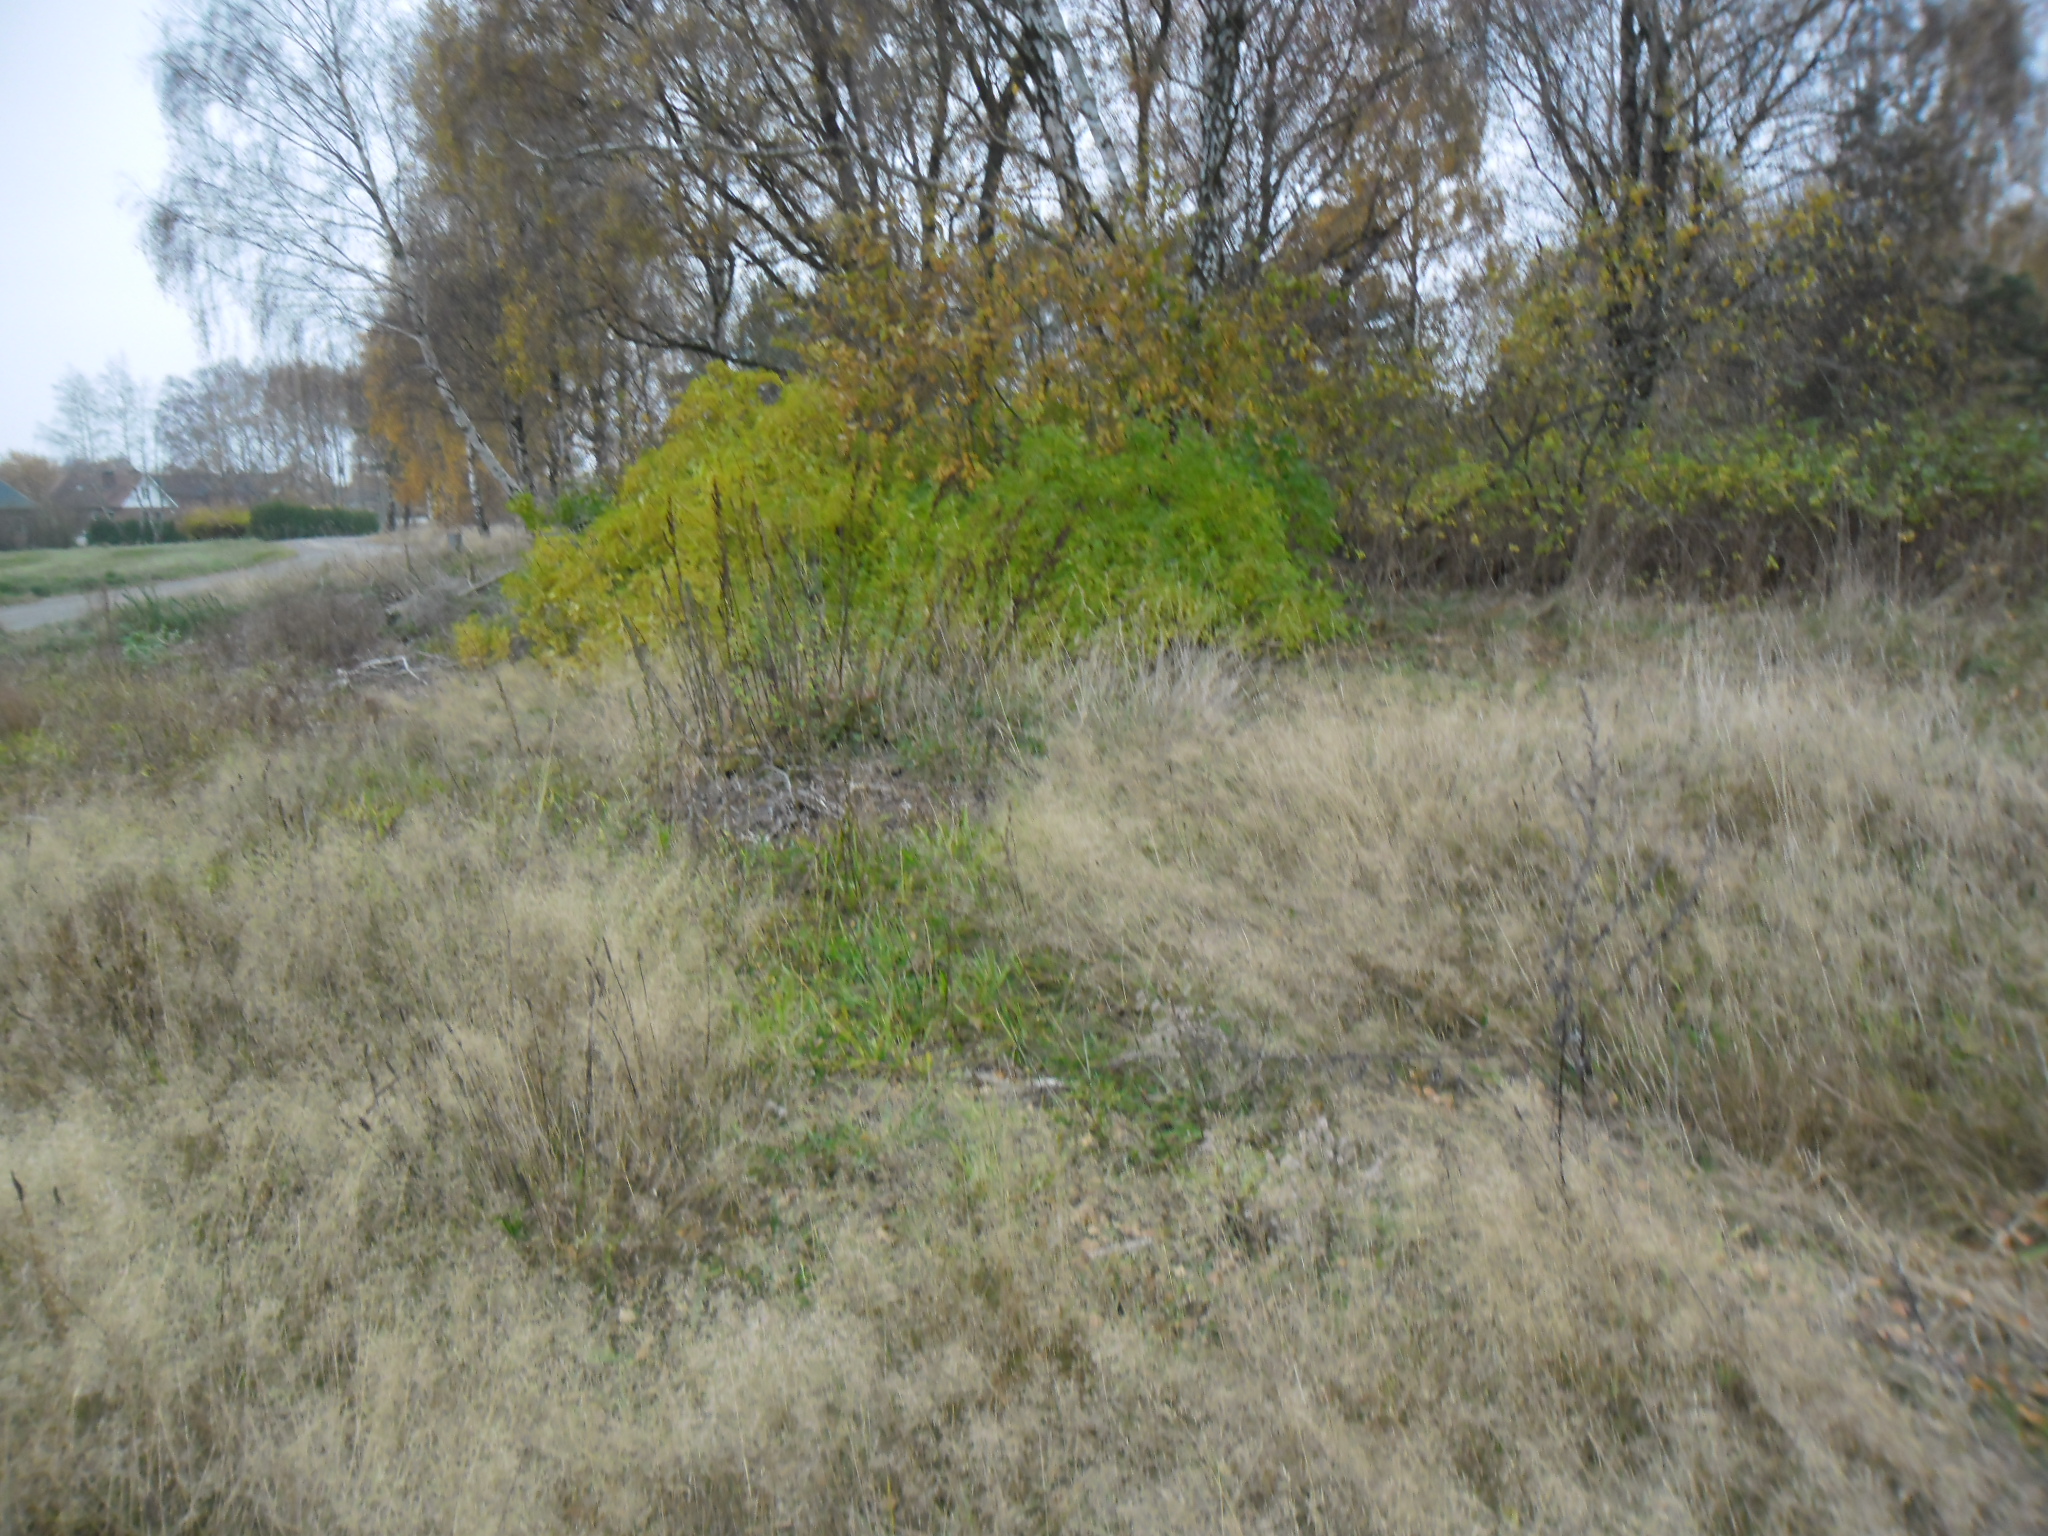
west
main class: Grassland
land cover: Grassland without tree/shrub cover
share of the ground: > 75 %
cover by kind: herbaceous plants 100 %
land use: Agriculture (excluding fallow land and kitchen gardens)
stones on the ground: 10 - 25 %
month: October
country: SE
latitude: 56.4196
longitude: 13.1258
